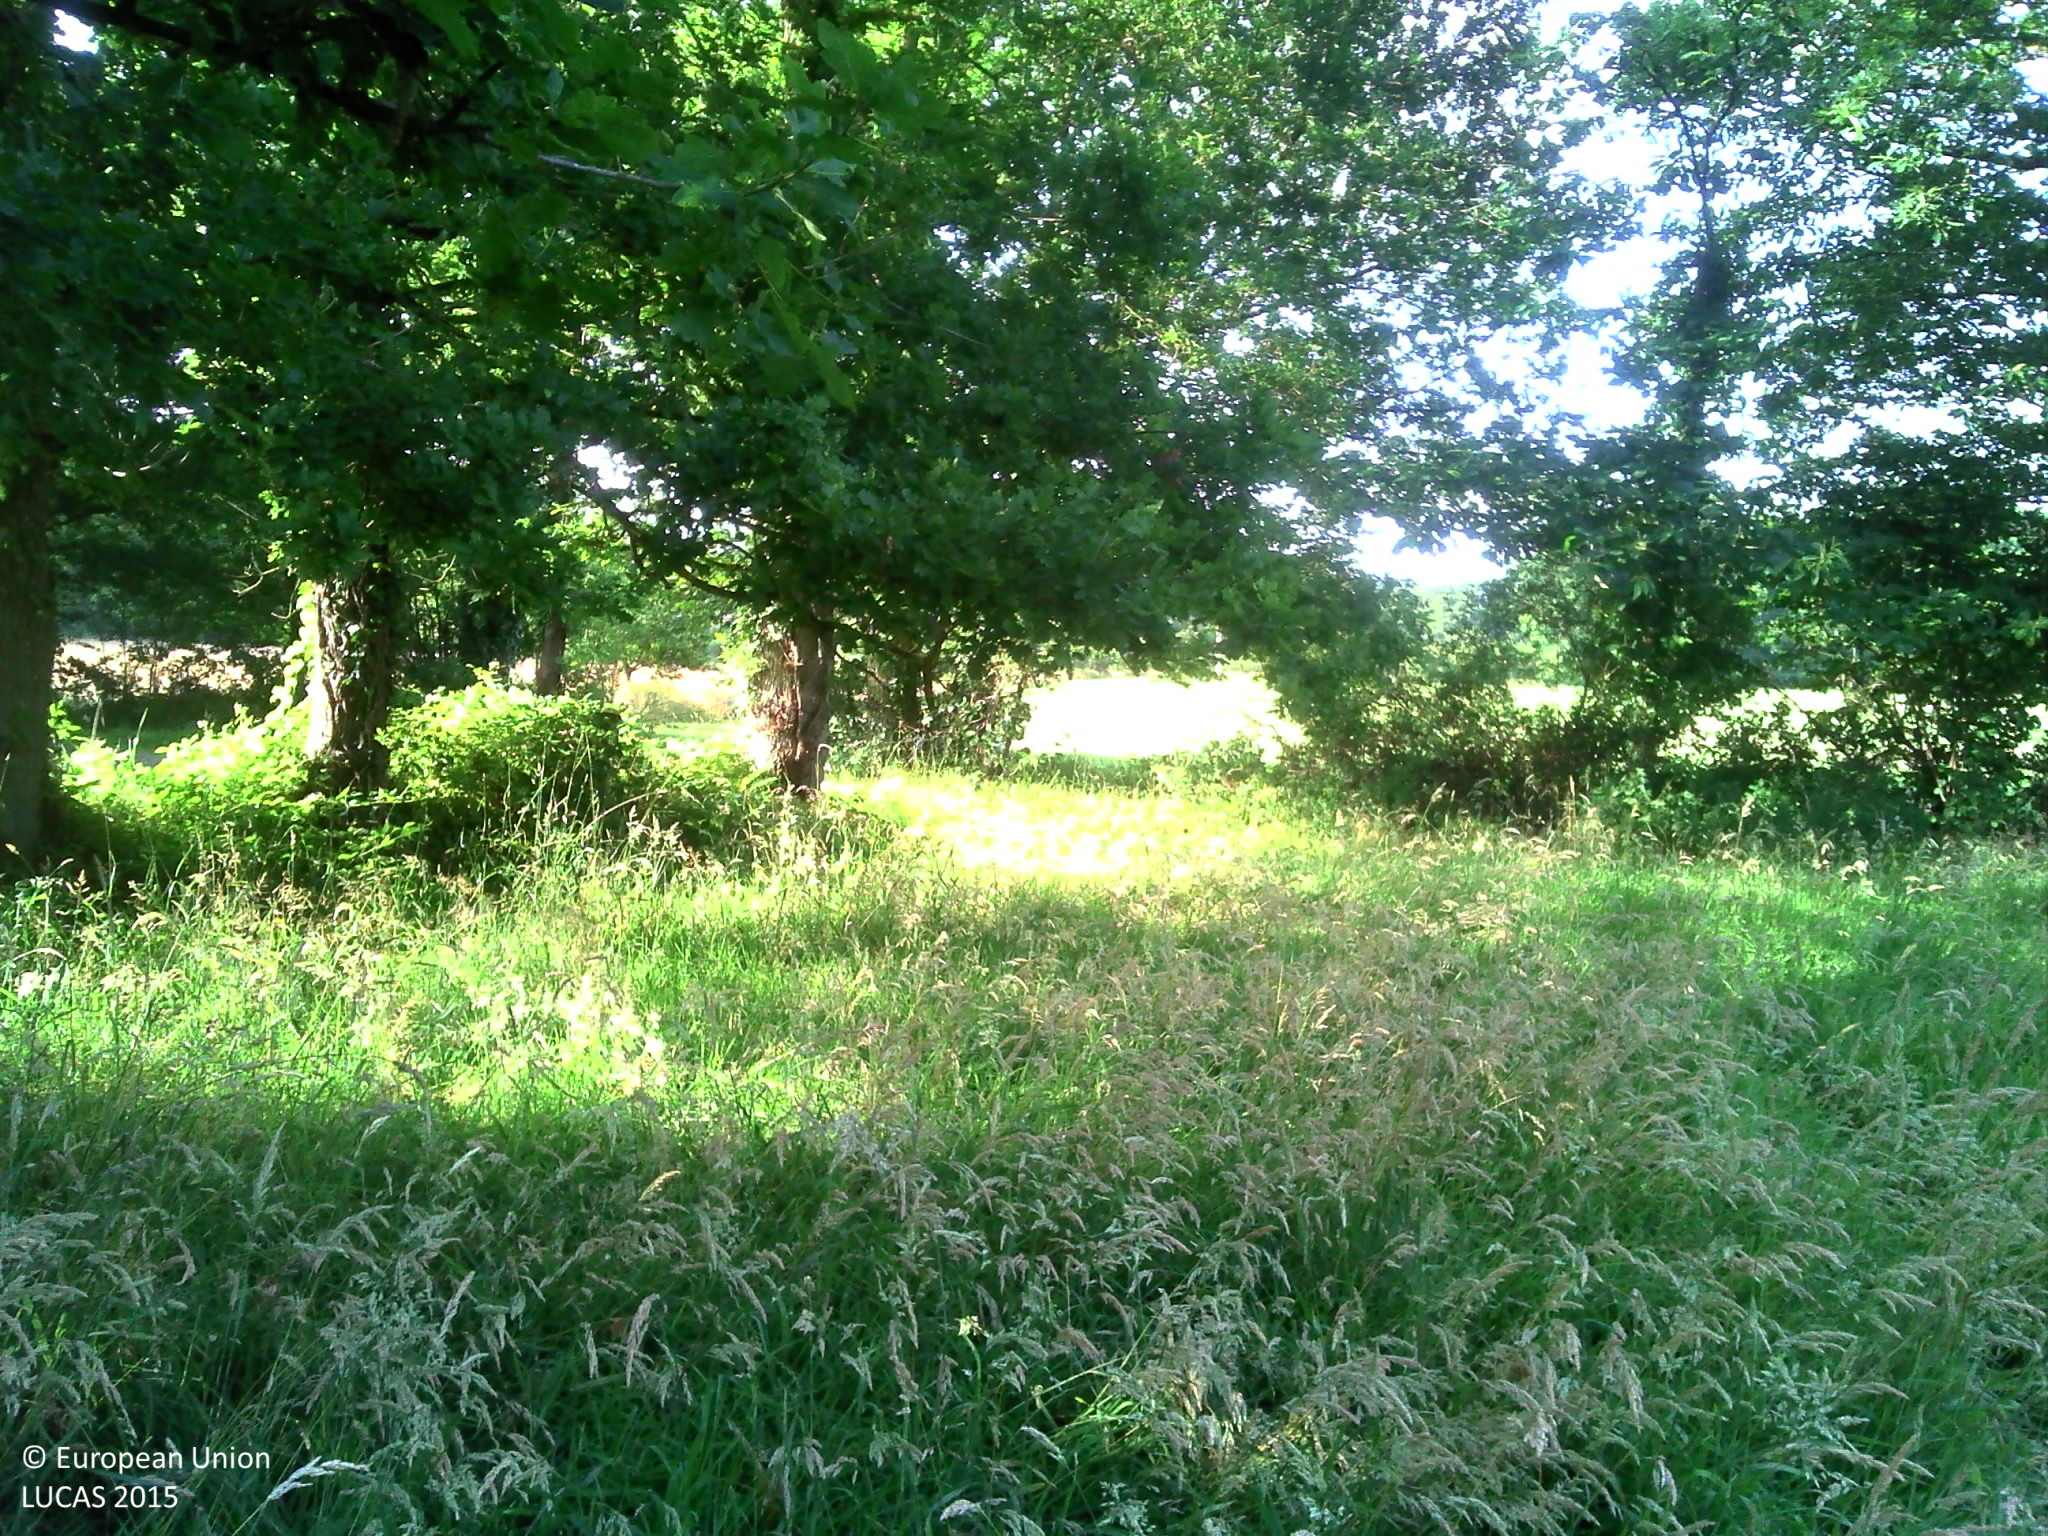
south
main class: Grassland
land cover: Grassland without tree/shrub cover
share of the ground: > 75 %
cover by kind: herbaceous plants 100 %
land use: Agriculture (excluding fallow land and kitchen gardens)
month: July
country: FR
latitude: 48.3563
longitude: -1.7507
